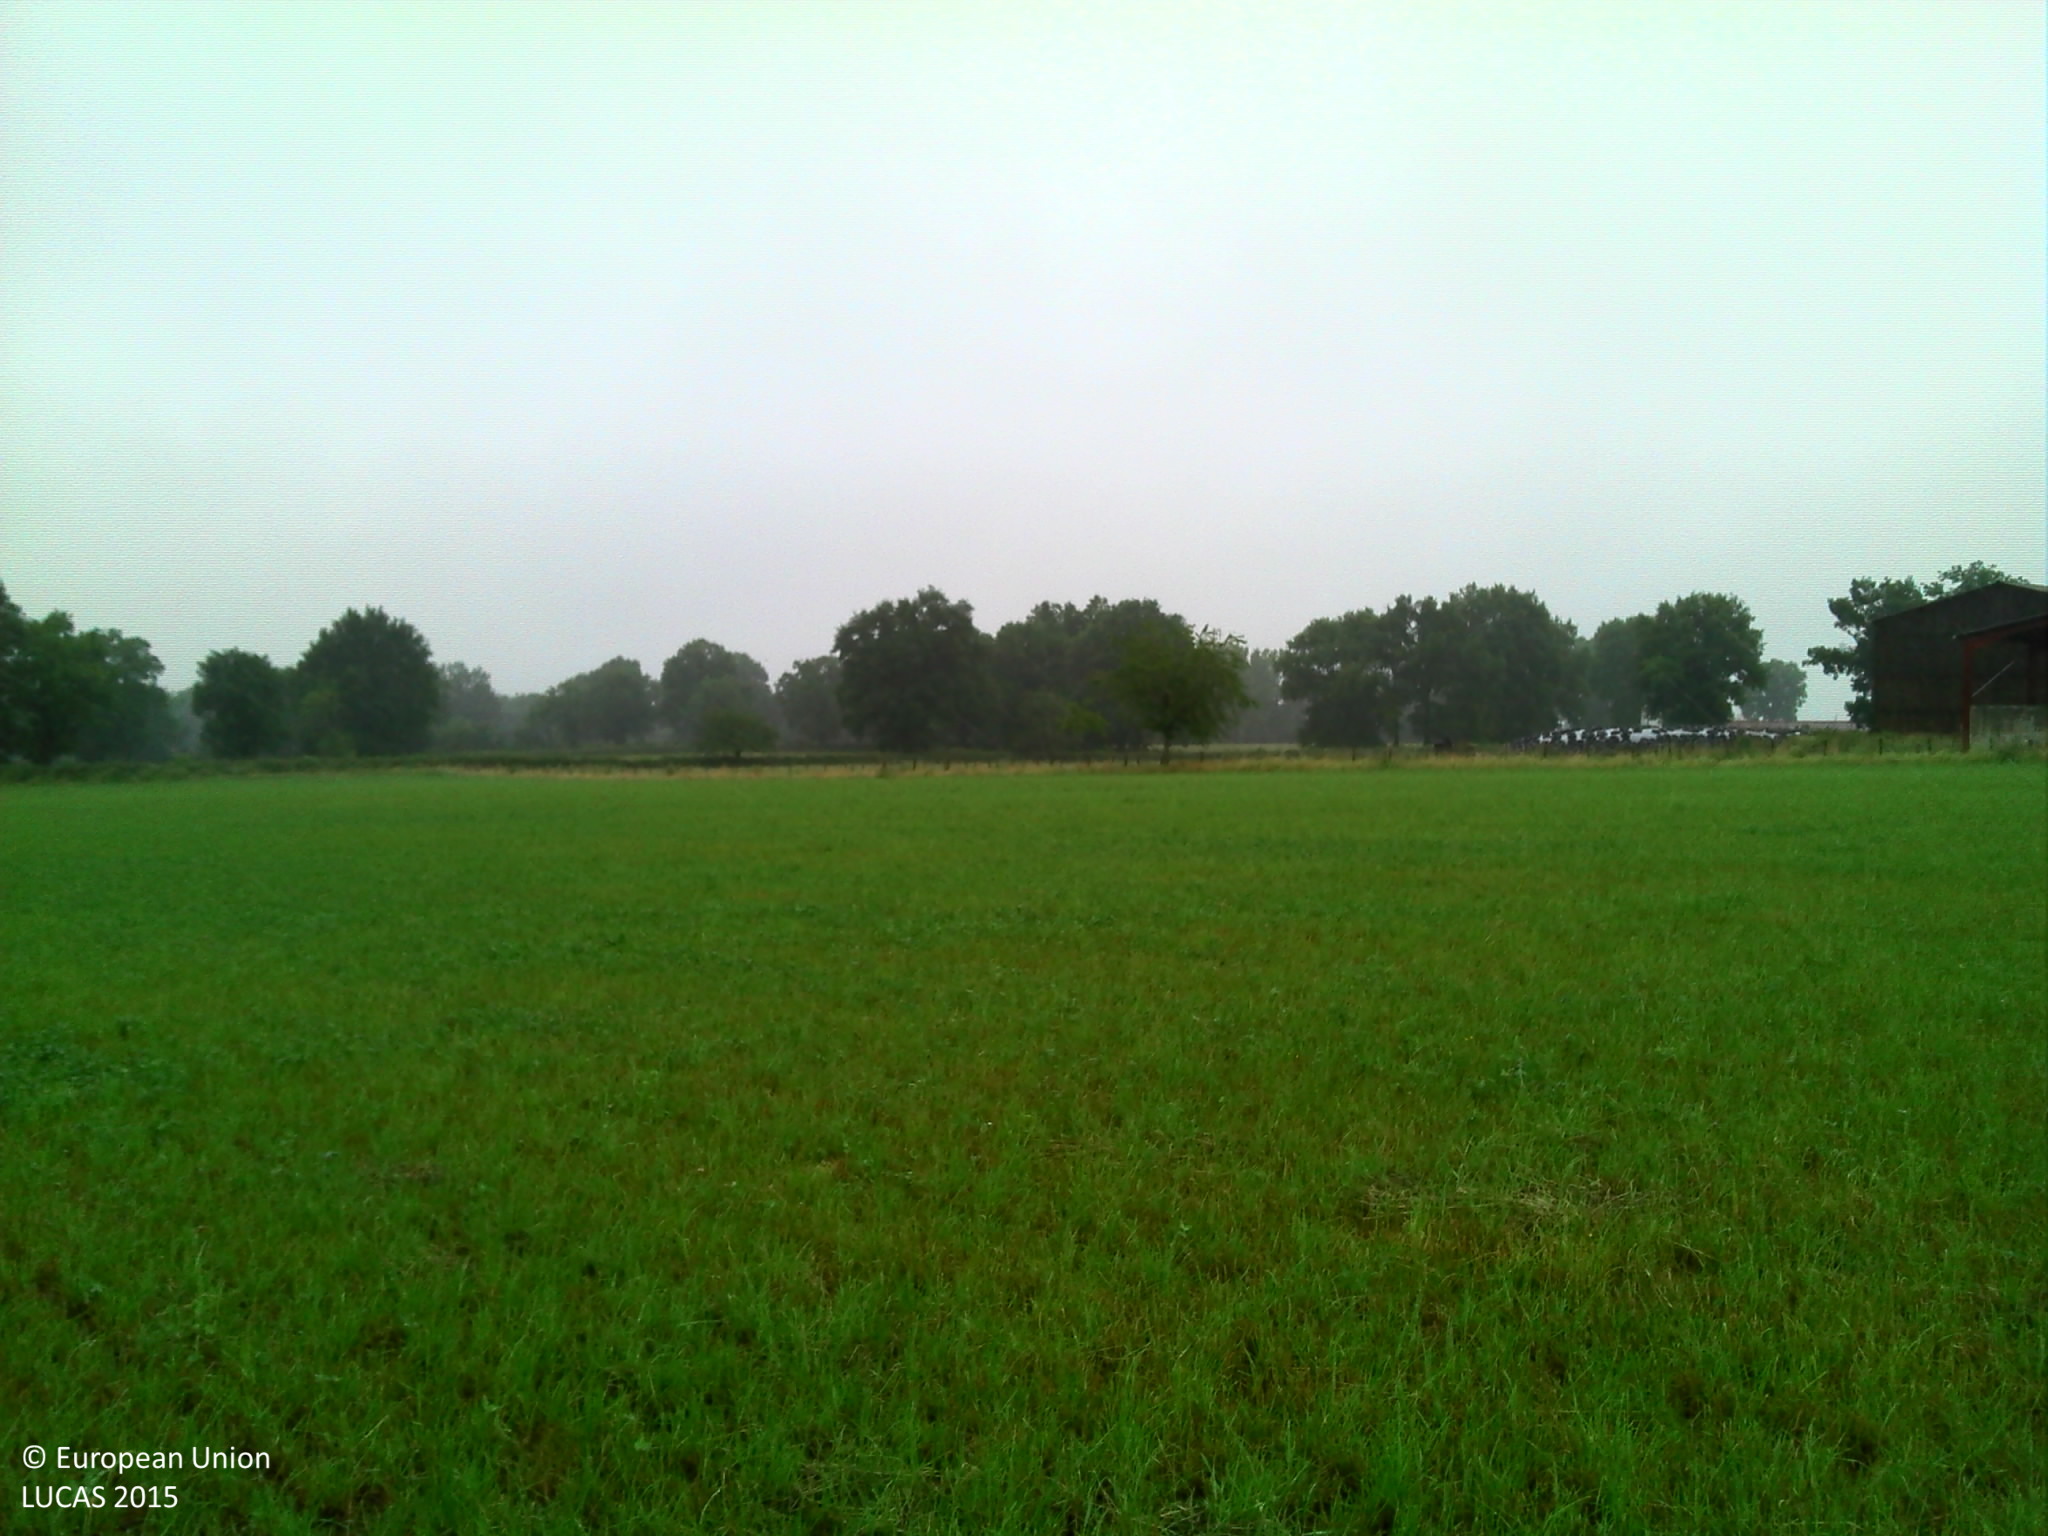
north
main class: Cropland
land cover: Temporary grasslands
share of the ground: > 75 %
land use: Agriculture (excluding fallow land and kitchen gardens)
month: June
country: FR
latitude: 46.4459
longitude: 2.9809
